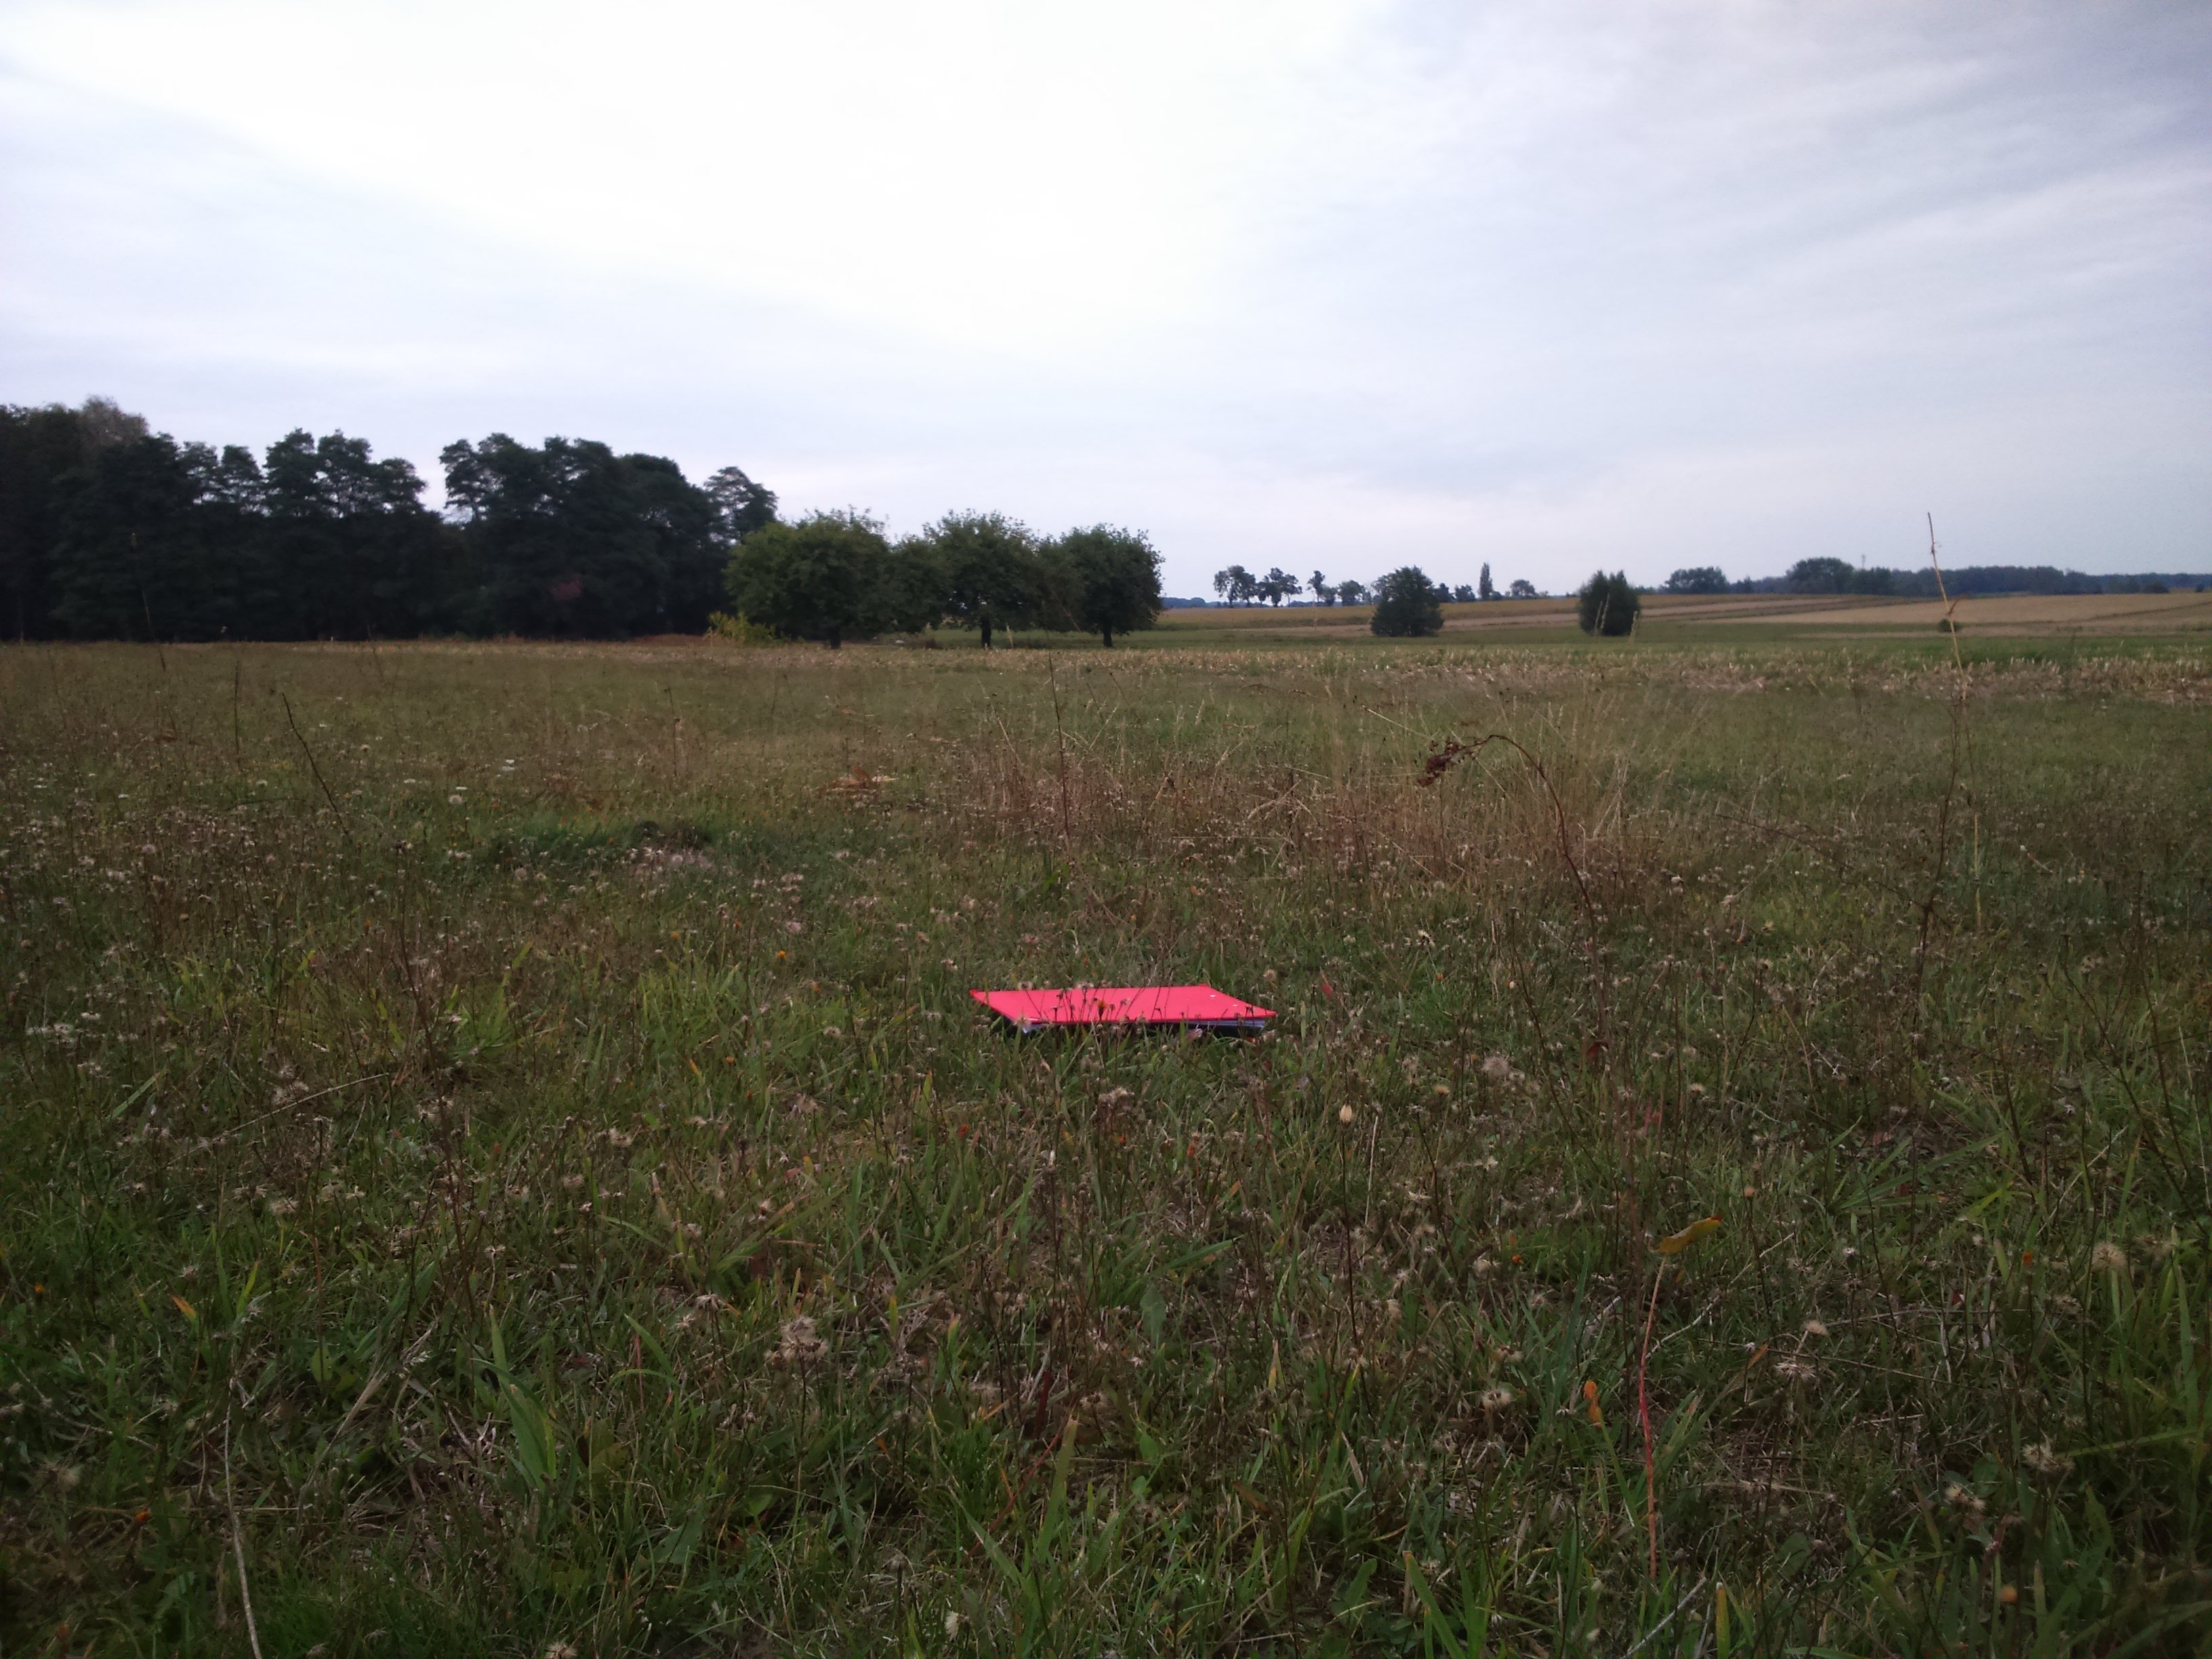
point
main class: Grassland
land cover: Grassland without tree/shrub cover
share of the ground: > 75 %
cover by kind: herbaceous plants 100 %
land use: Agriculture (excluding fallow land and kitchen gardens)
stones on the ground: < 10 %
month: September
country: PL
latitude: 52.3221
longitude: 22.0755
